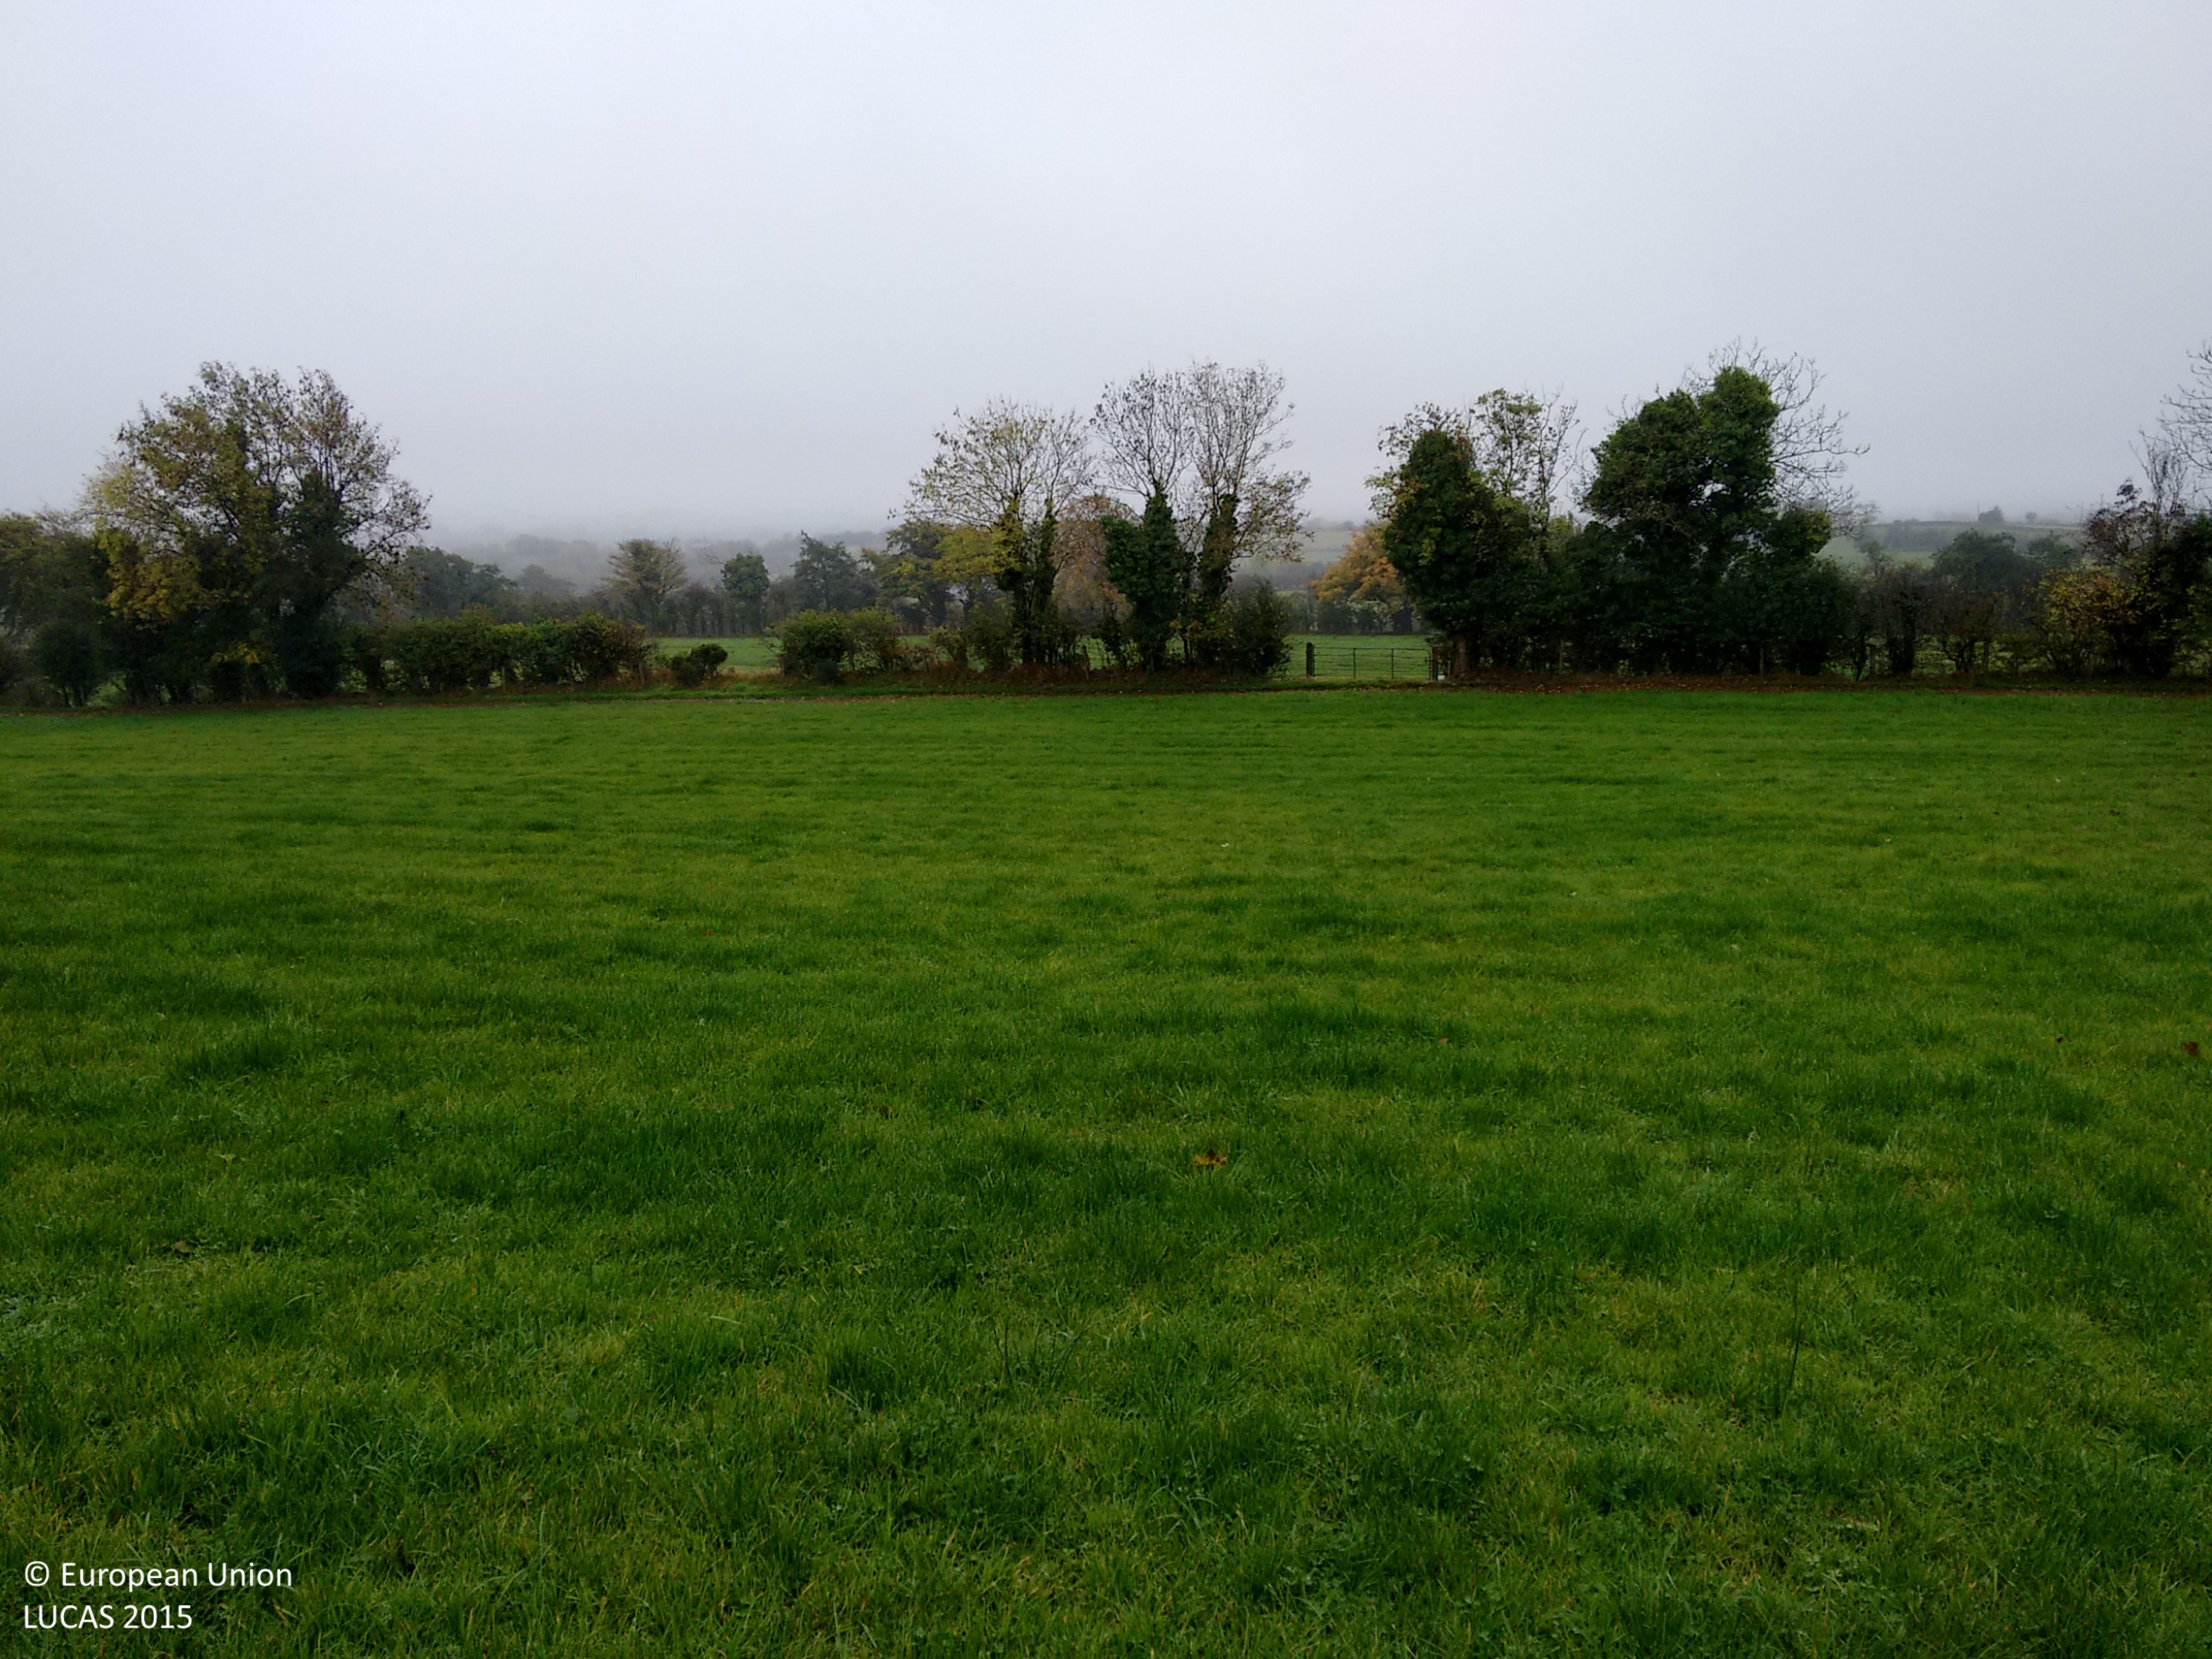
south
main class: Grassland
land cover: Grassland without tree/shrub cover
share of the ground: > 75 %
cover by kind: herbaceous plants 100 %
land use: Agriculture (excluding fallow land and kitchen gardens)
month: October
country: GB
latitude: 54.5568
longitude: -7.4251
